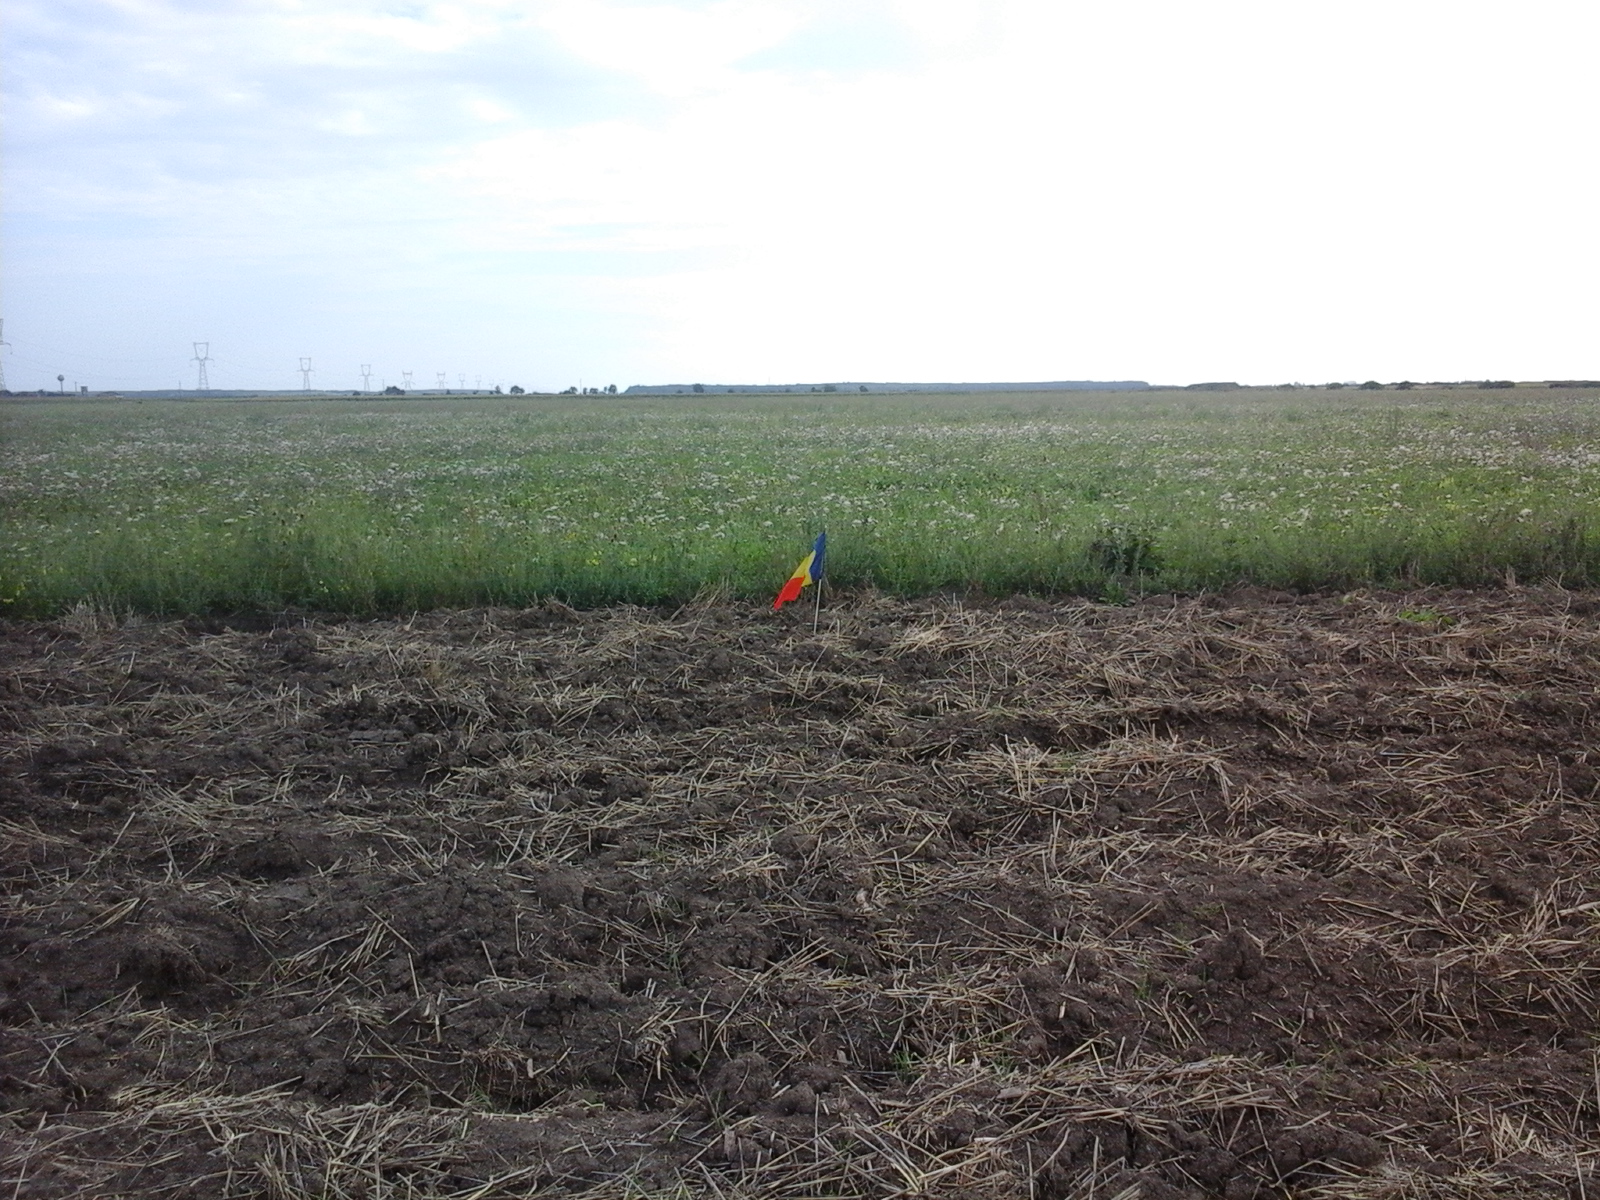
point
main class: Cropland
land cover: Common wheat
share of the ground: < 10 %
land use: Agriculture (excluding fallow land and kitchen gardens)
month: August
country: RO
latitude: 46.7310
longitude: 21.6479
